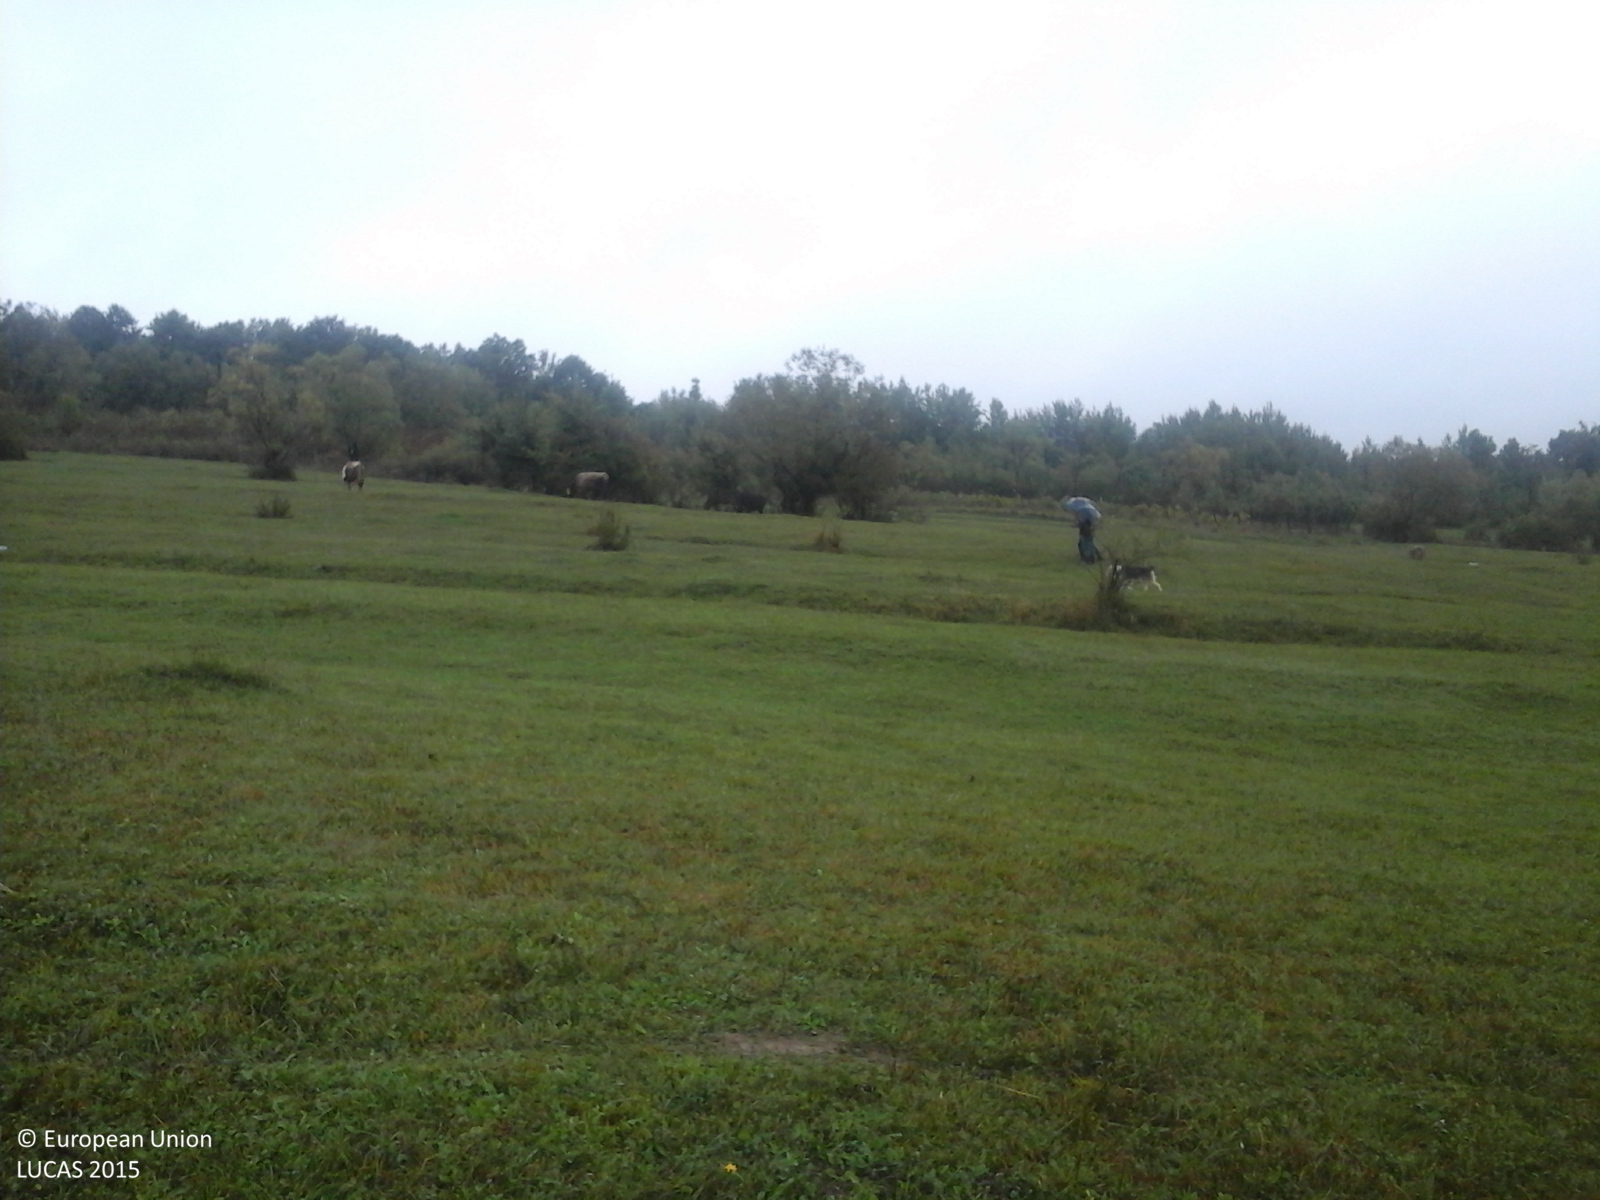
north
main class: Grassland
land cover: Grassland without tree/shrub cover
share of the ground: > 75 %
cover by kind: herbaceous plants 100 %
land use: Agriculture (excluding fallow land and kitchen gardens)
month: September
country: RO
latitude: 45.1451
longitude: 23.6307
